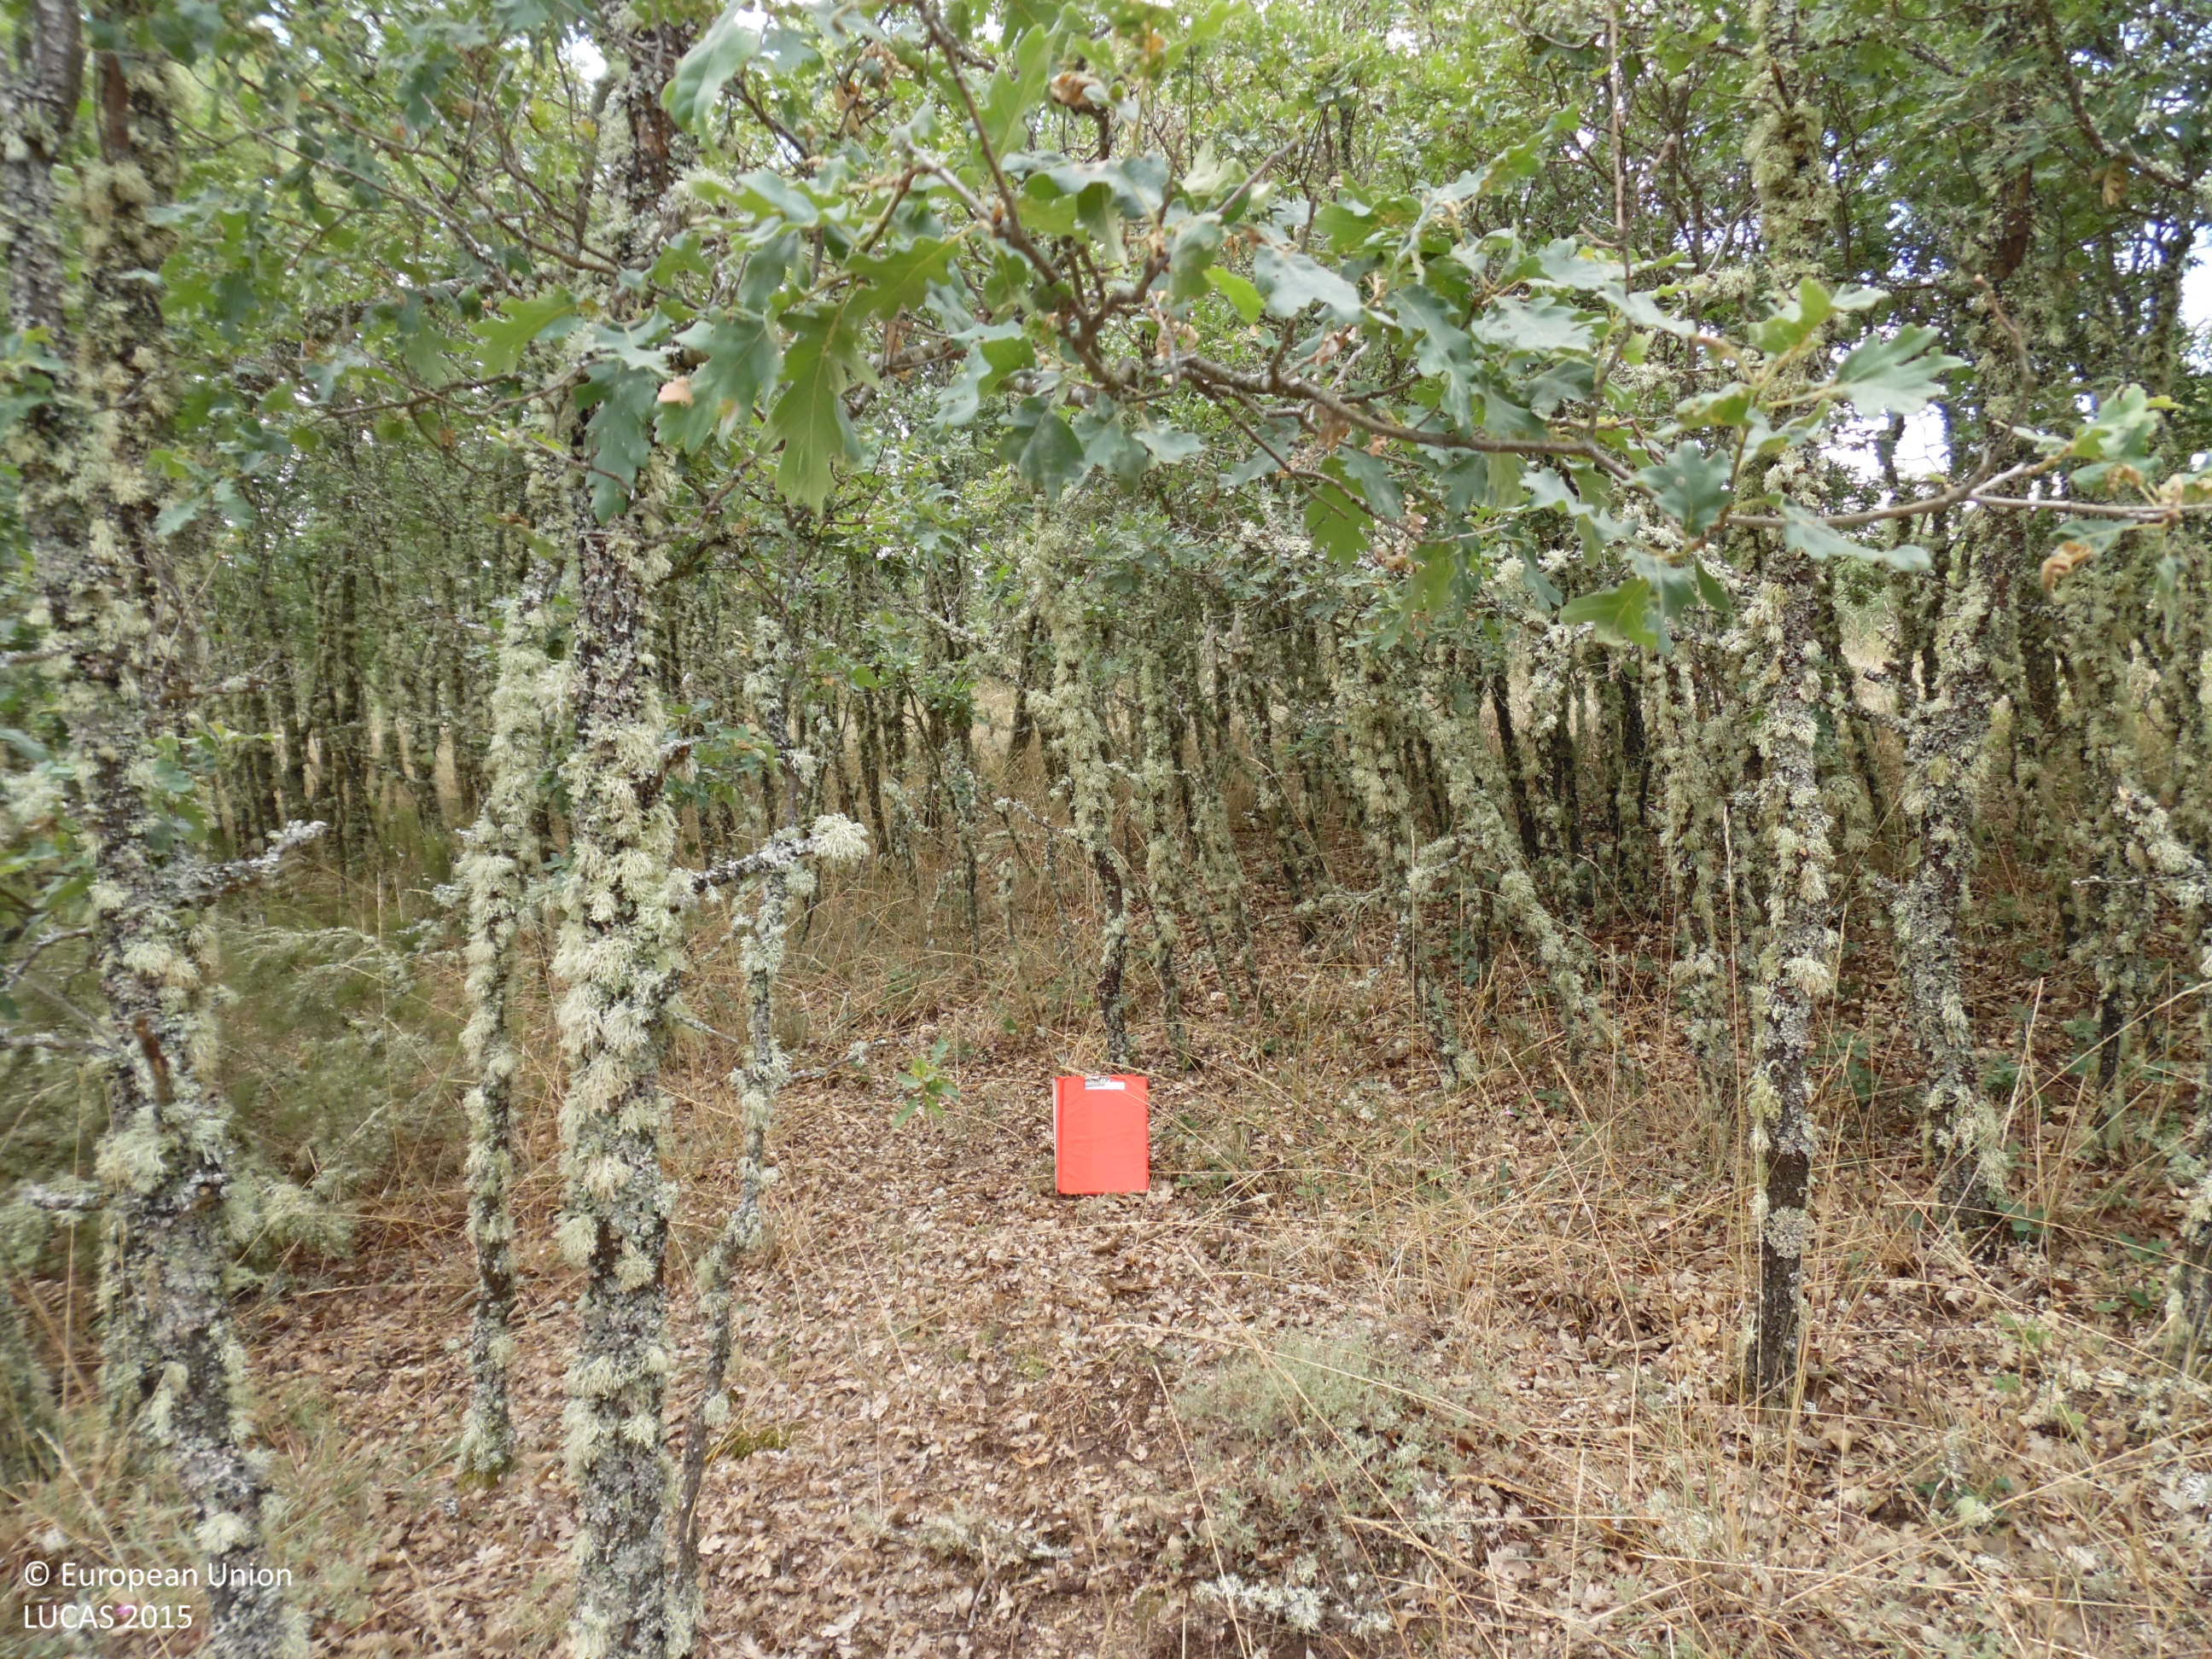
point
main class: Woodland
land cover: Broadleaved woodland
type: thermophilous deciduous forest
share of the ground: > 75 %
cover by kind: broadleaved forest trees 90 %, shrubs 5 %, herbaceous plants 5 %
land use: Forestry
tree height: > 5 m
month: July
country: ES
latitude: 42.6608
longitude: -5.7542
